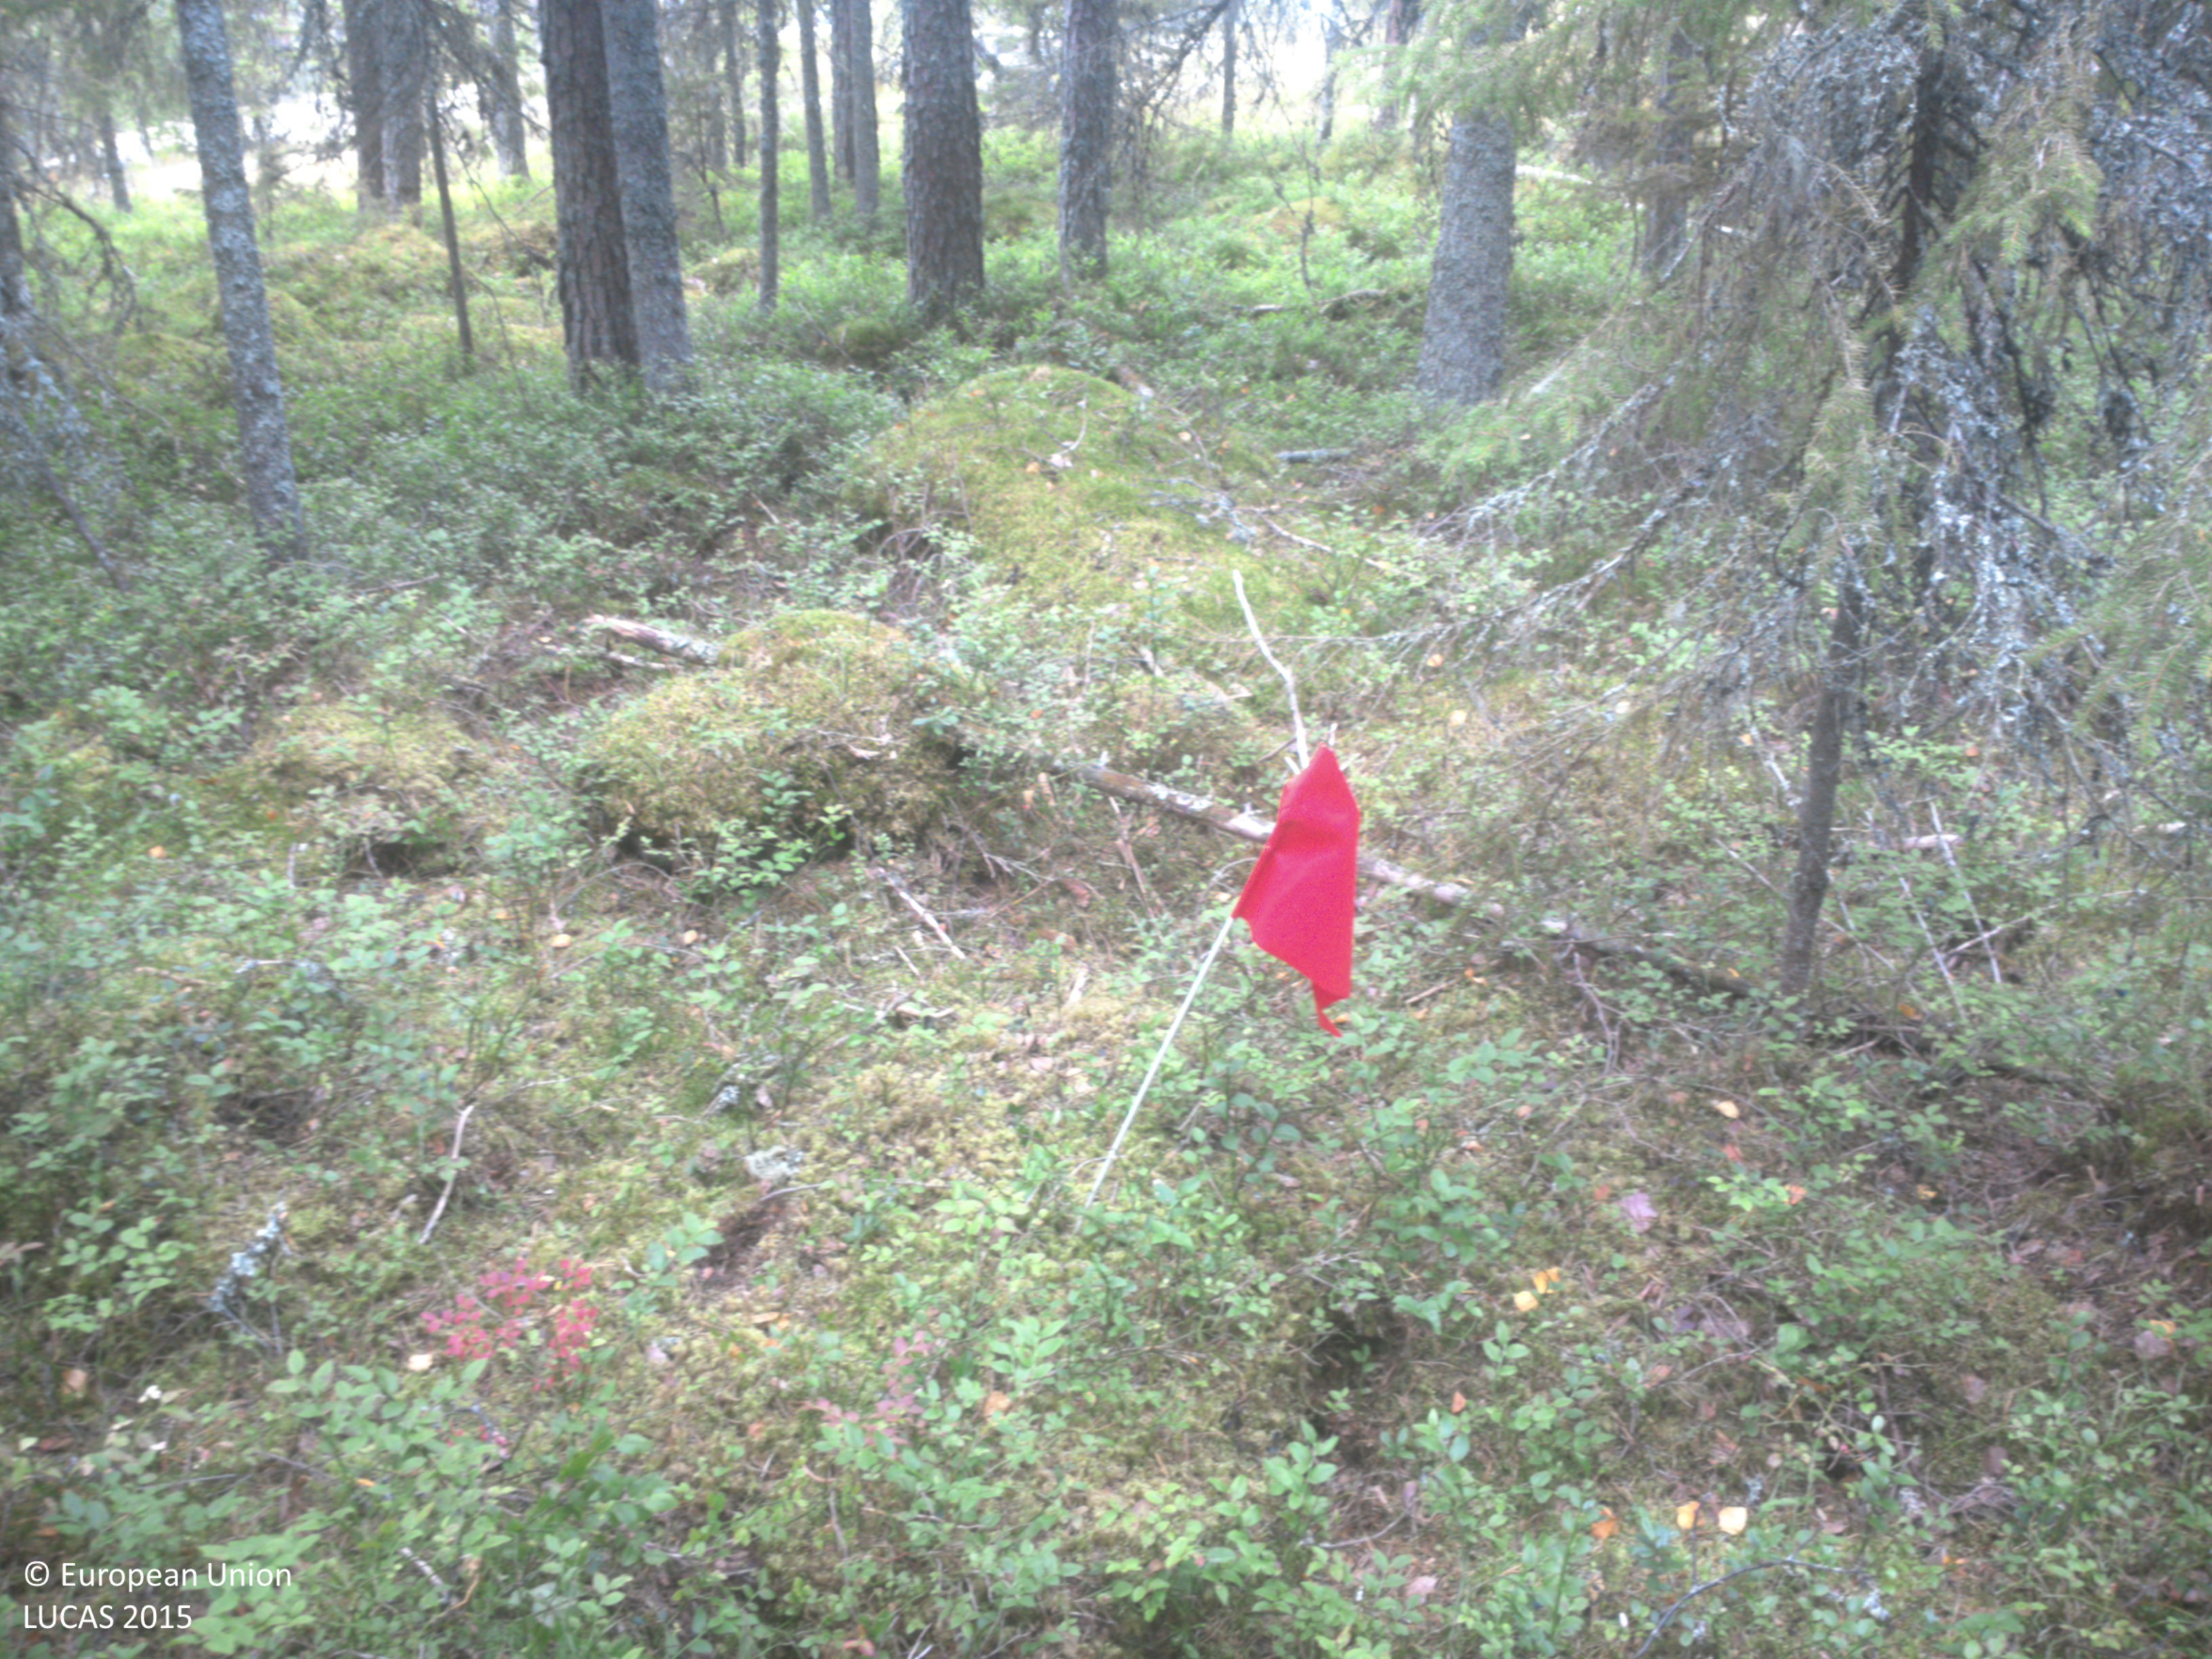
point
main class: Woodland
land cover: Other coniferous woodland
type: boreal forest
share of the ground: 50 - 75 %
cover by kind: coniferous forest trees 50 %, shrubs 50 %
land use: Forestry
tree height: > 5 m
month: August
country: SE
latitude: 63.6428
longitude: 19.4471
